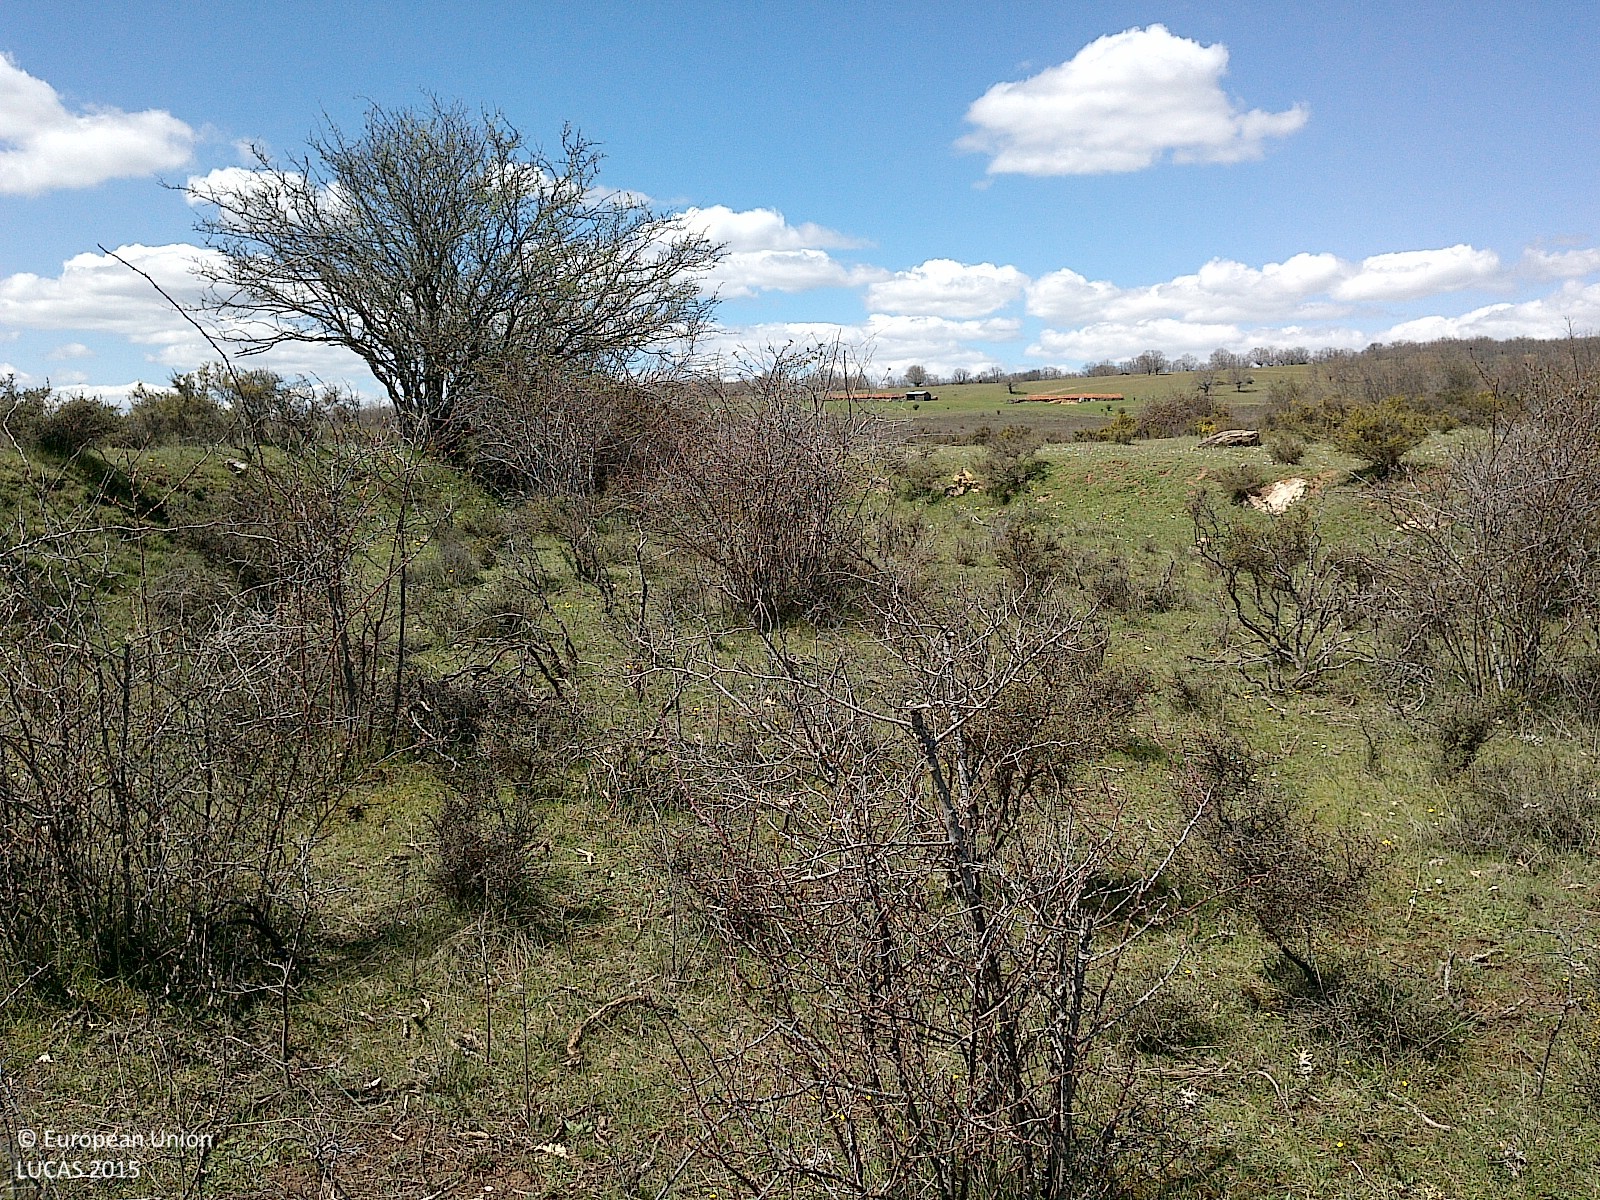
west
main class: Shrubland
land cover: Shrubland without tree cover
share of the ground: 50 - 75 %
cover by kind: shrubs 55 %, herbaceous plants 45 %
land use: Agriculture (excluding fallow land and kitchen gardens)
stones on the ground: < 10 %
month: April
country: ES
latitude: 42.1171
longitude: -3.3208
